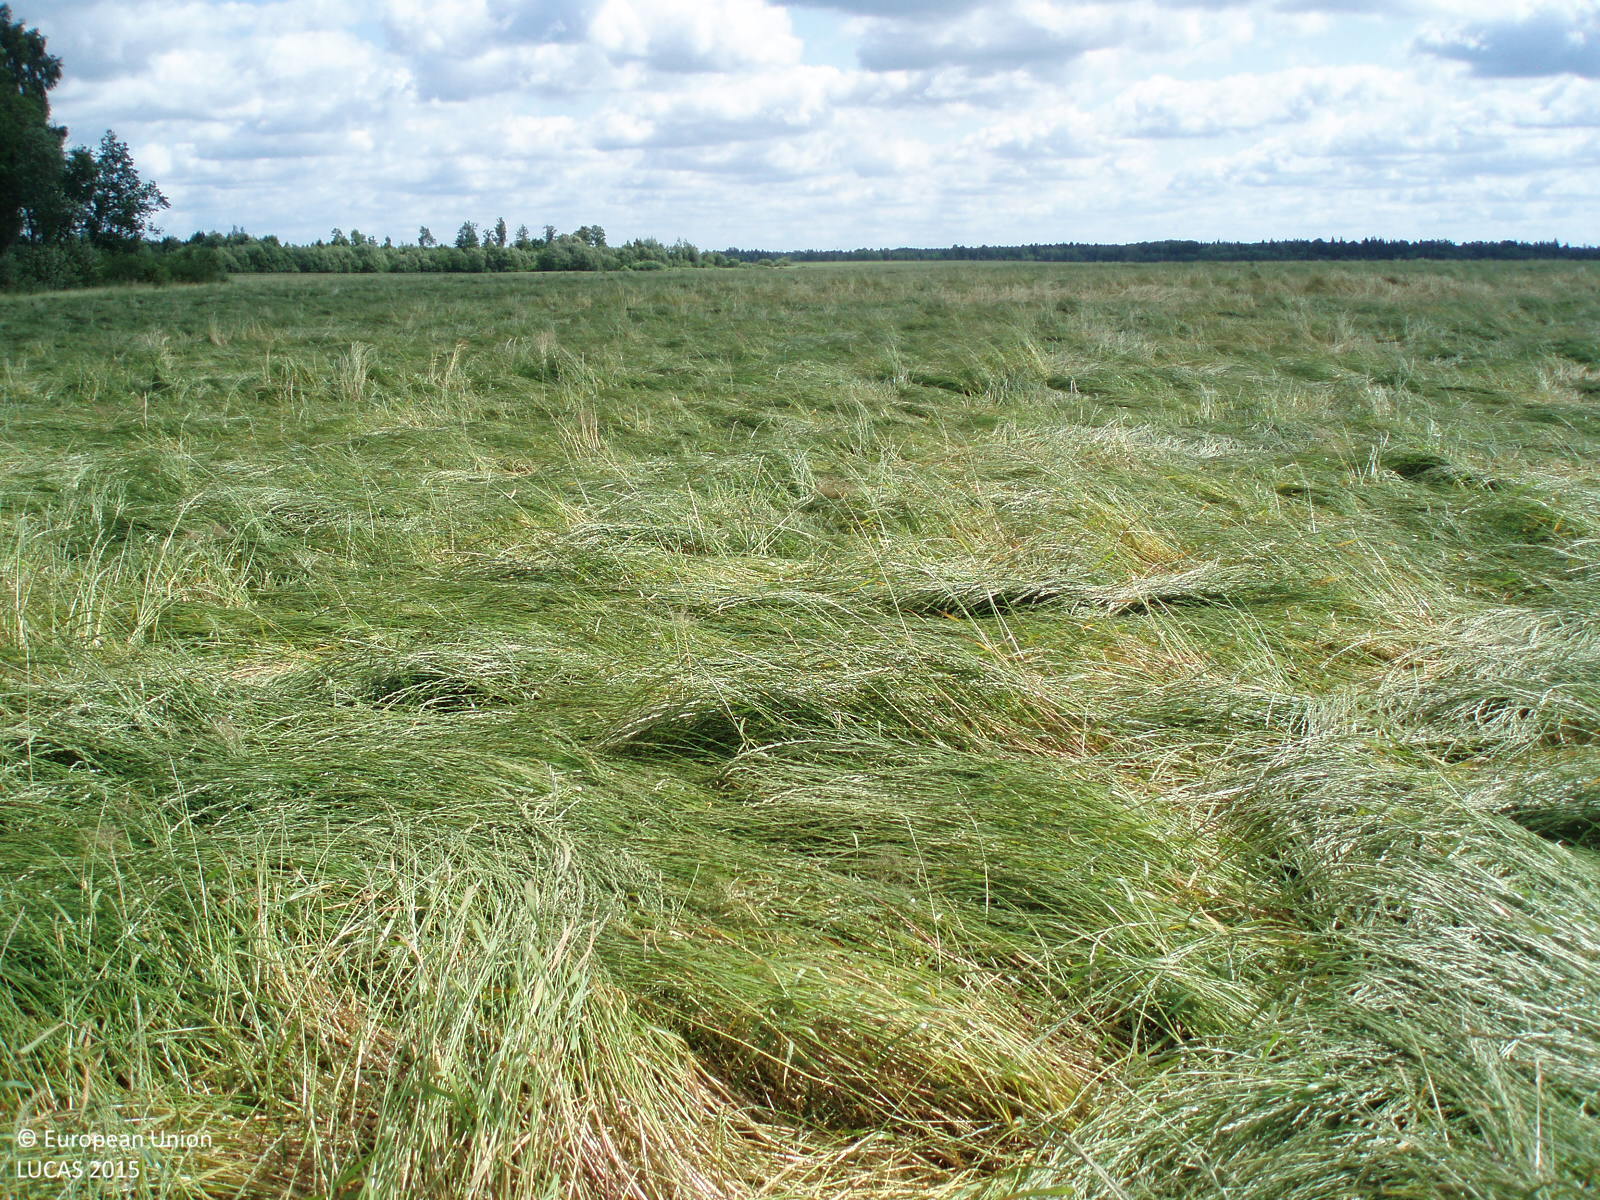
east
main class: Cropland
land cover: Temporary grasslands
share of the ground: > 75 %
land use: Agriculture (excluding fallow land and kitchen gardens)
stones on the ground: < 10 %
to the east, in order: Temporary grasslands
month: July
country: LT
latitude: 56.0942
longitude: 22.9416
